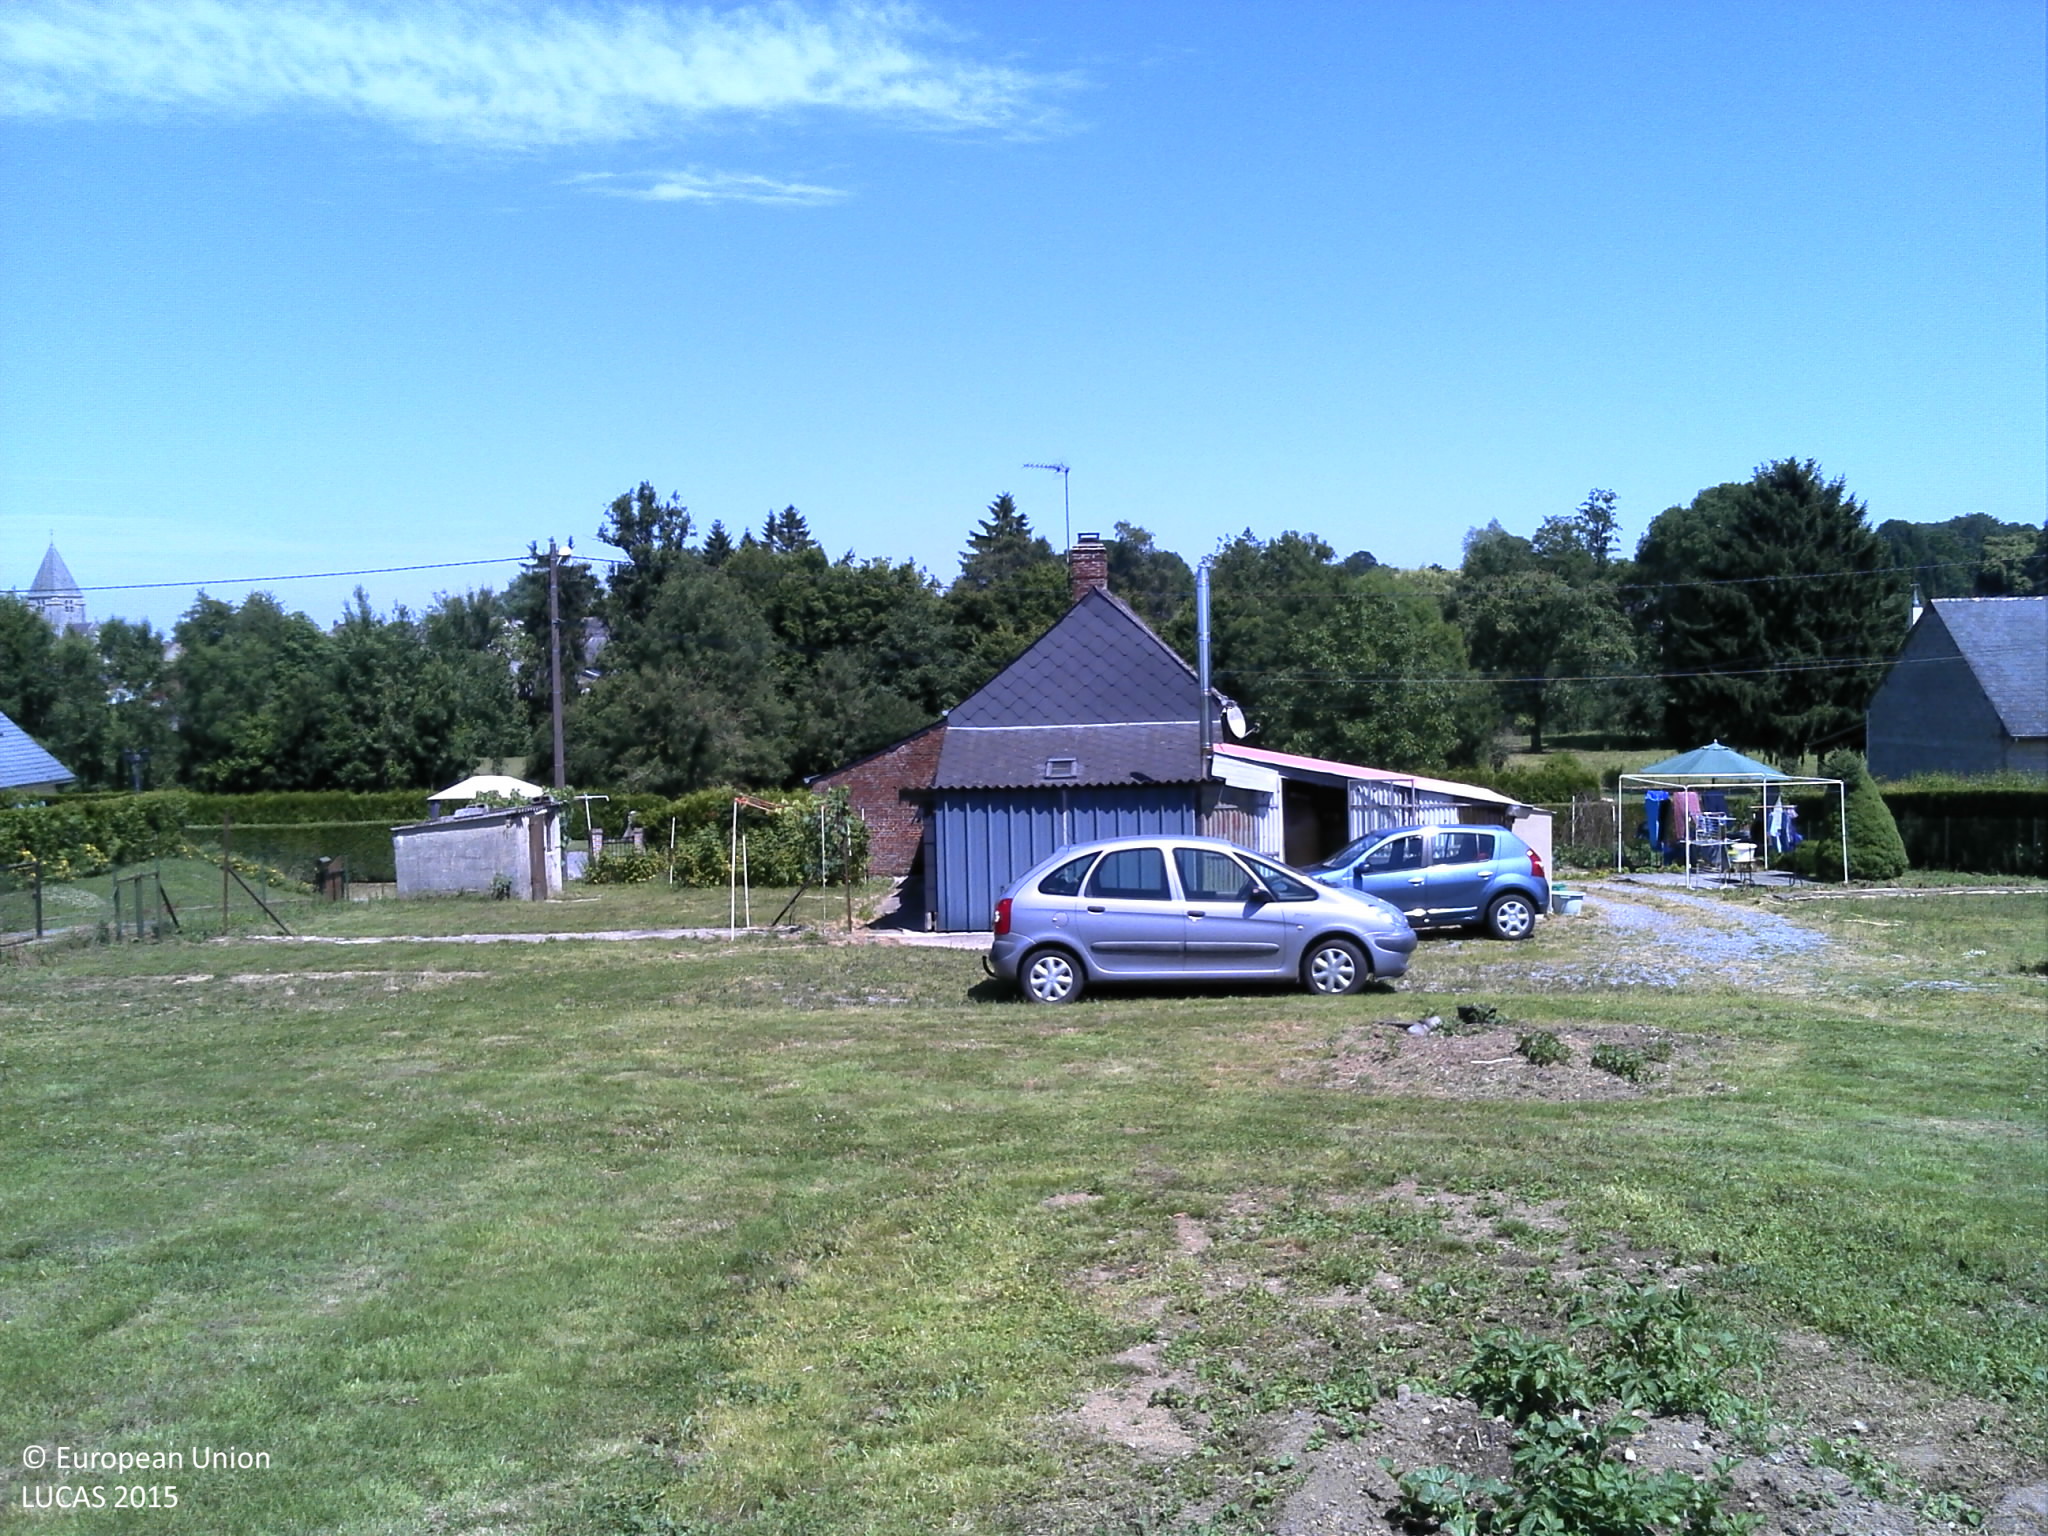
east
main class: Grassland
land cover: Grassland with sparse tree/shrub cover
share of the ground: > 75 %
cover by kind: herbaceous plants 95 %, coniferous forest trees 5 %
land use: Residential
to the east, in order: Grassland with sparse tree/shrub cover; Artificial constructions in urban areas; Grassland without tree/shrub cover; Paved roads, cycling and walking lanes; Grass margins; Fences; Grassland without tree/shrub cover; Artificial constructions in urban areas; Grassland without tree/shrub cover; Broadleaved woodland; Tracks; Ditches and canals; Fences; Grassland without tree/shrub cover; Broadleaved woodland; Grassland with sparse tree/shrub cover; Broadleaved woodland; Paved roads, cycling and walking lanes; Grassland with sparse tree/shrub cover; Inland fresh running water
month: July
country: FR
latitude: 49.8216
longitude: 4.2269
